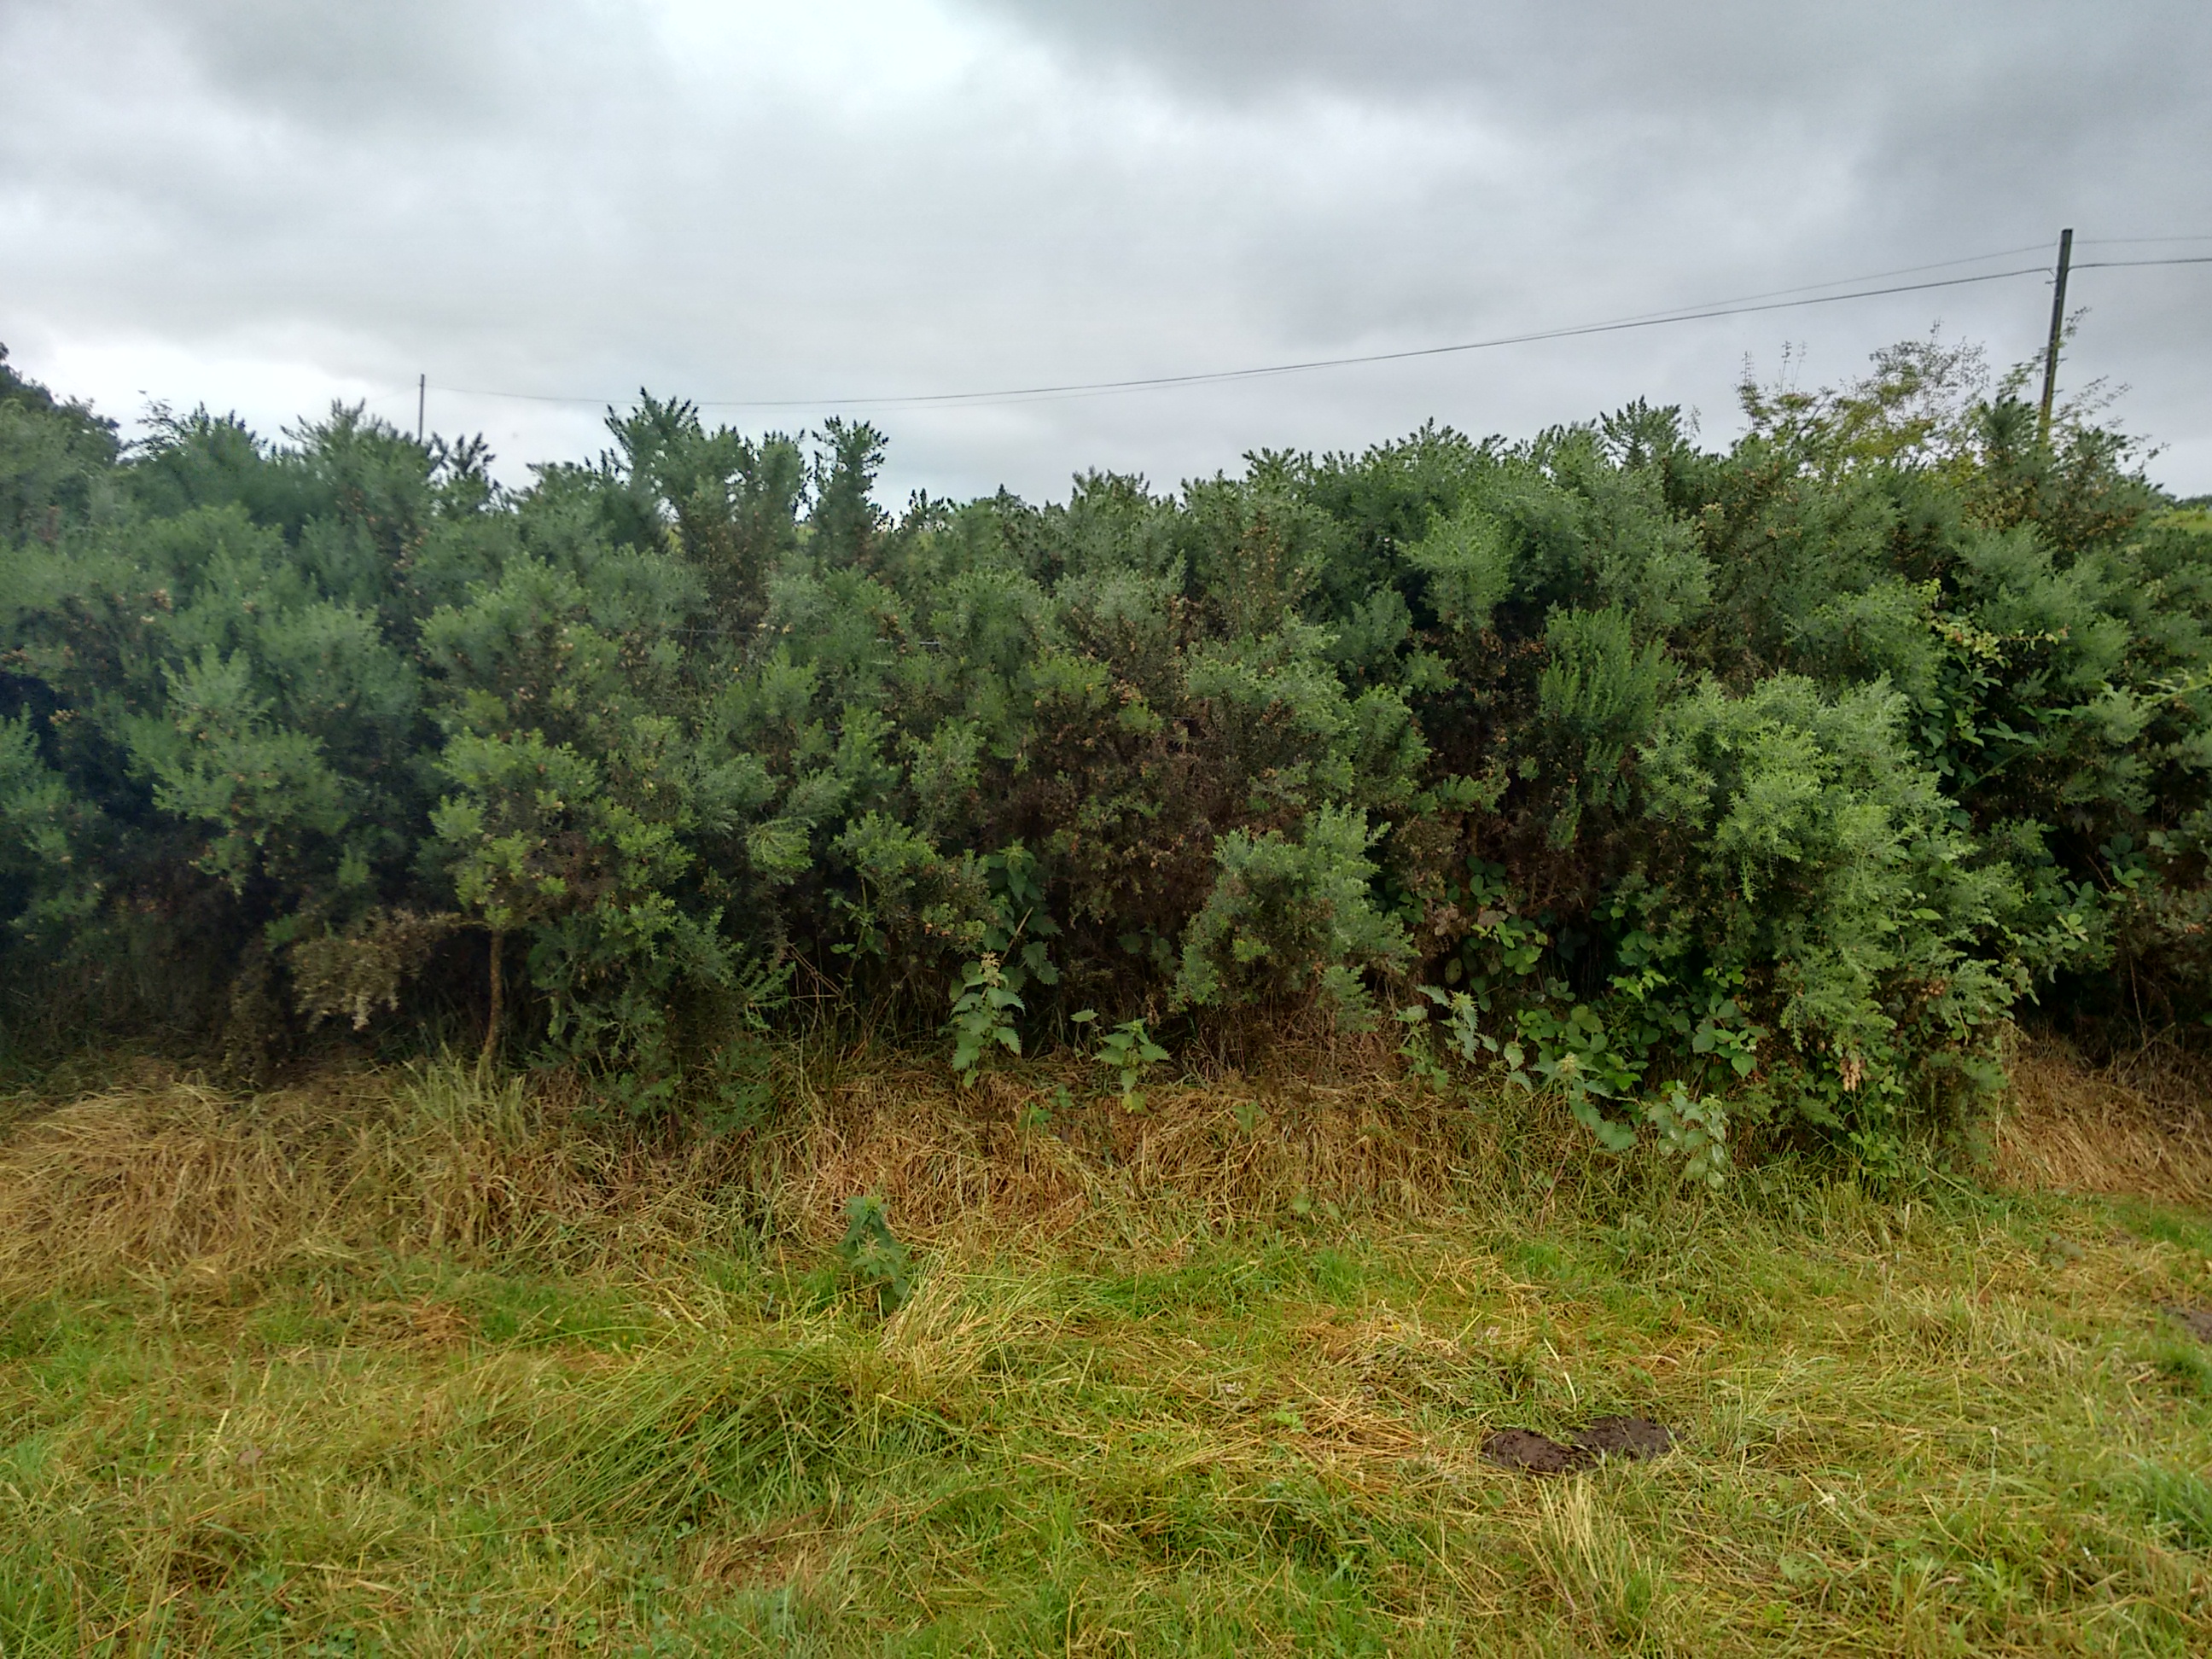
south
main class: Grassland
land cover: Grassland without tree/shrub cover
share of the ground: > 75 %
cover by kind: herbaceous plants 100 %
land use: Agriculture (excluding fallow land and kitchen gardens)
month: July
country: GB
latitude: 54.5214
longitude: -7.1543
